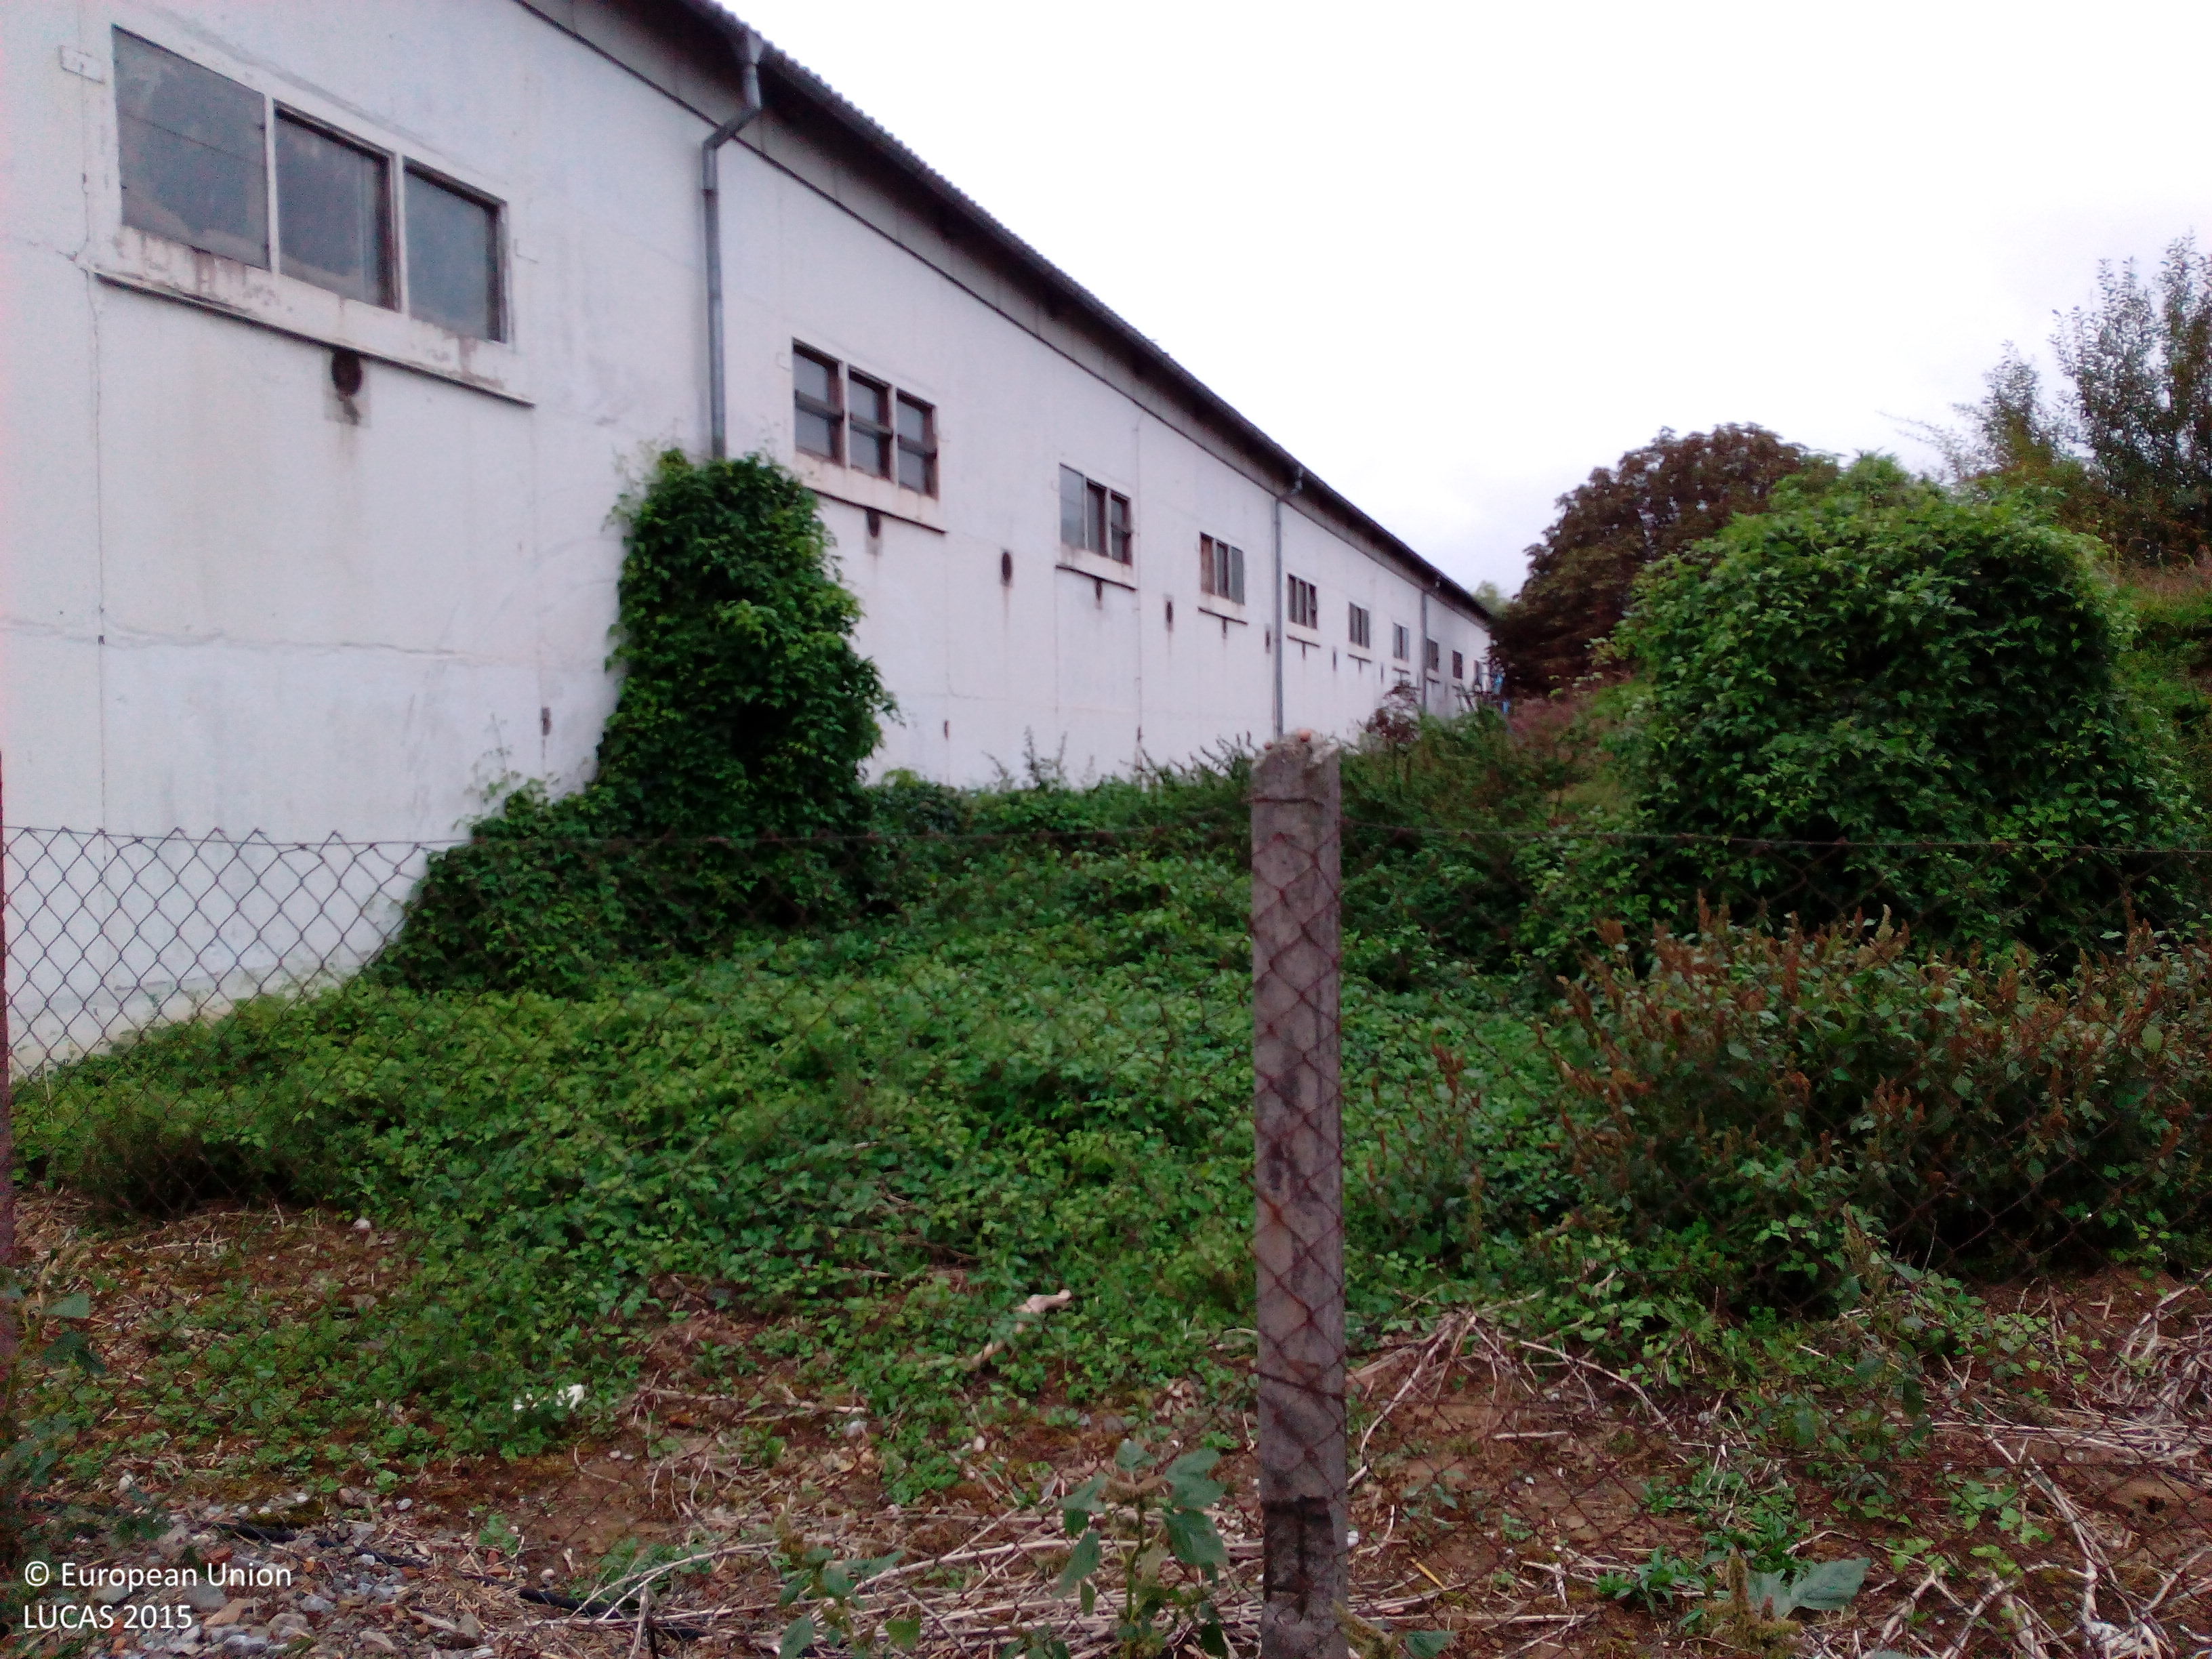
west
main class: Shrubland
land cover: Shrubland without tree cover
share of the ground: > 75 %
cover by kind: shrubs 90 %, herbaceous plants 10 %
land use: Semi-natural and natural areas not in use
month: September
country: DE
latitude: 51.8158
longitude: 11.0296
